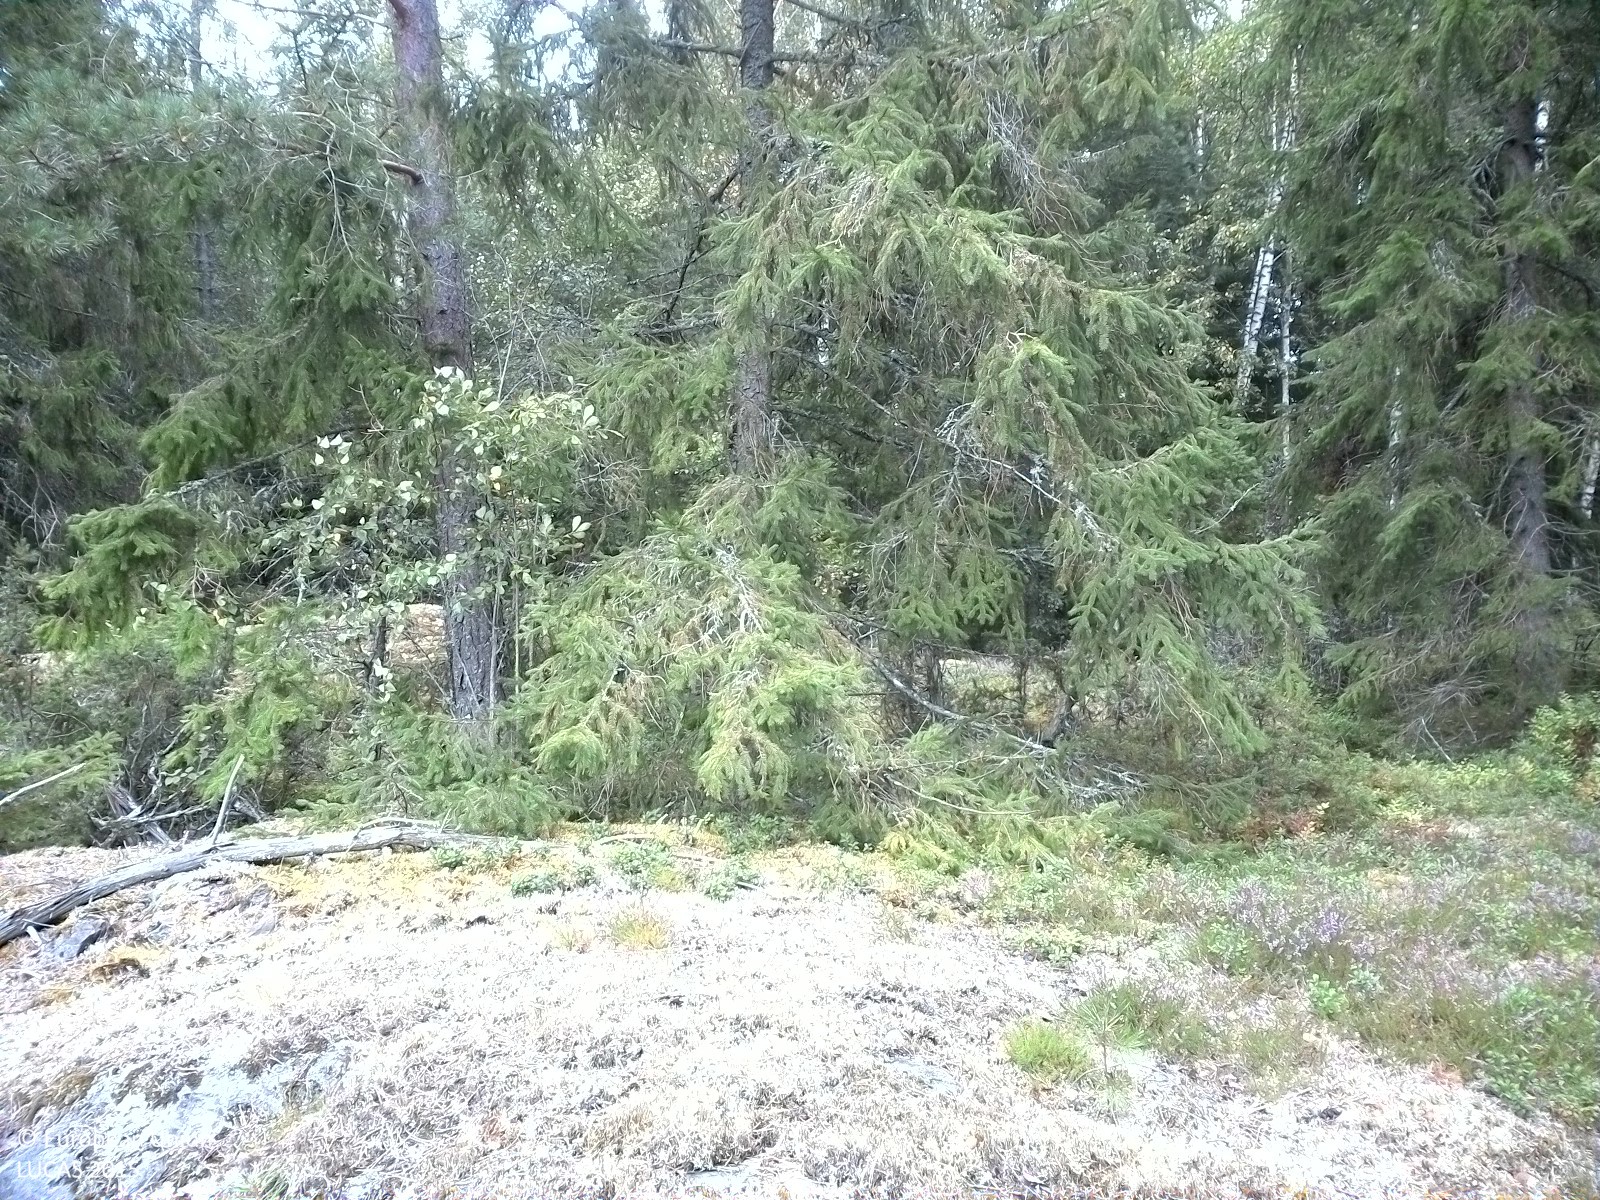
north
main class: Shrubland
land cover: Shrubland with sparse tree cover
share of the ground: 50 - 75 %
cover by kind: shrubs 55 %, lichens and mosses 20 %, coniferous forest trees 5 %
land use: Semi-natural and natural areas not in use
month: August
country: SE
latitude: 59.0070
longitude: 15.5468
